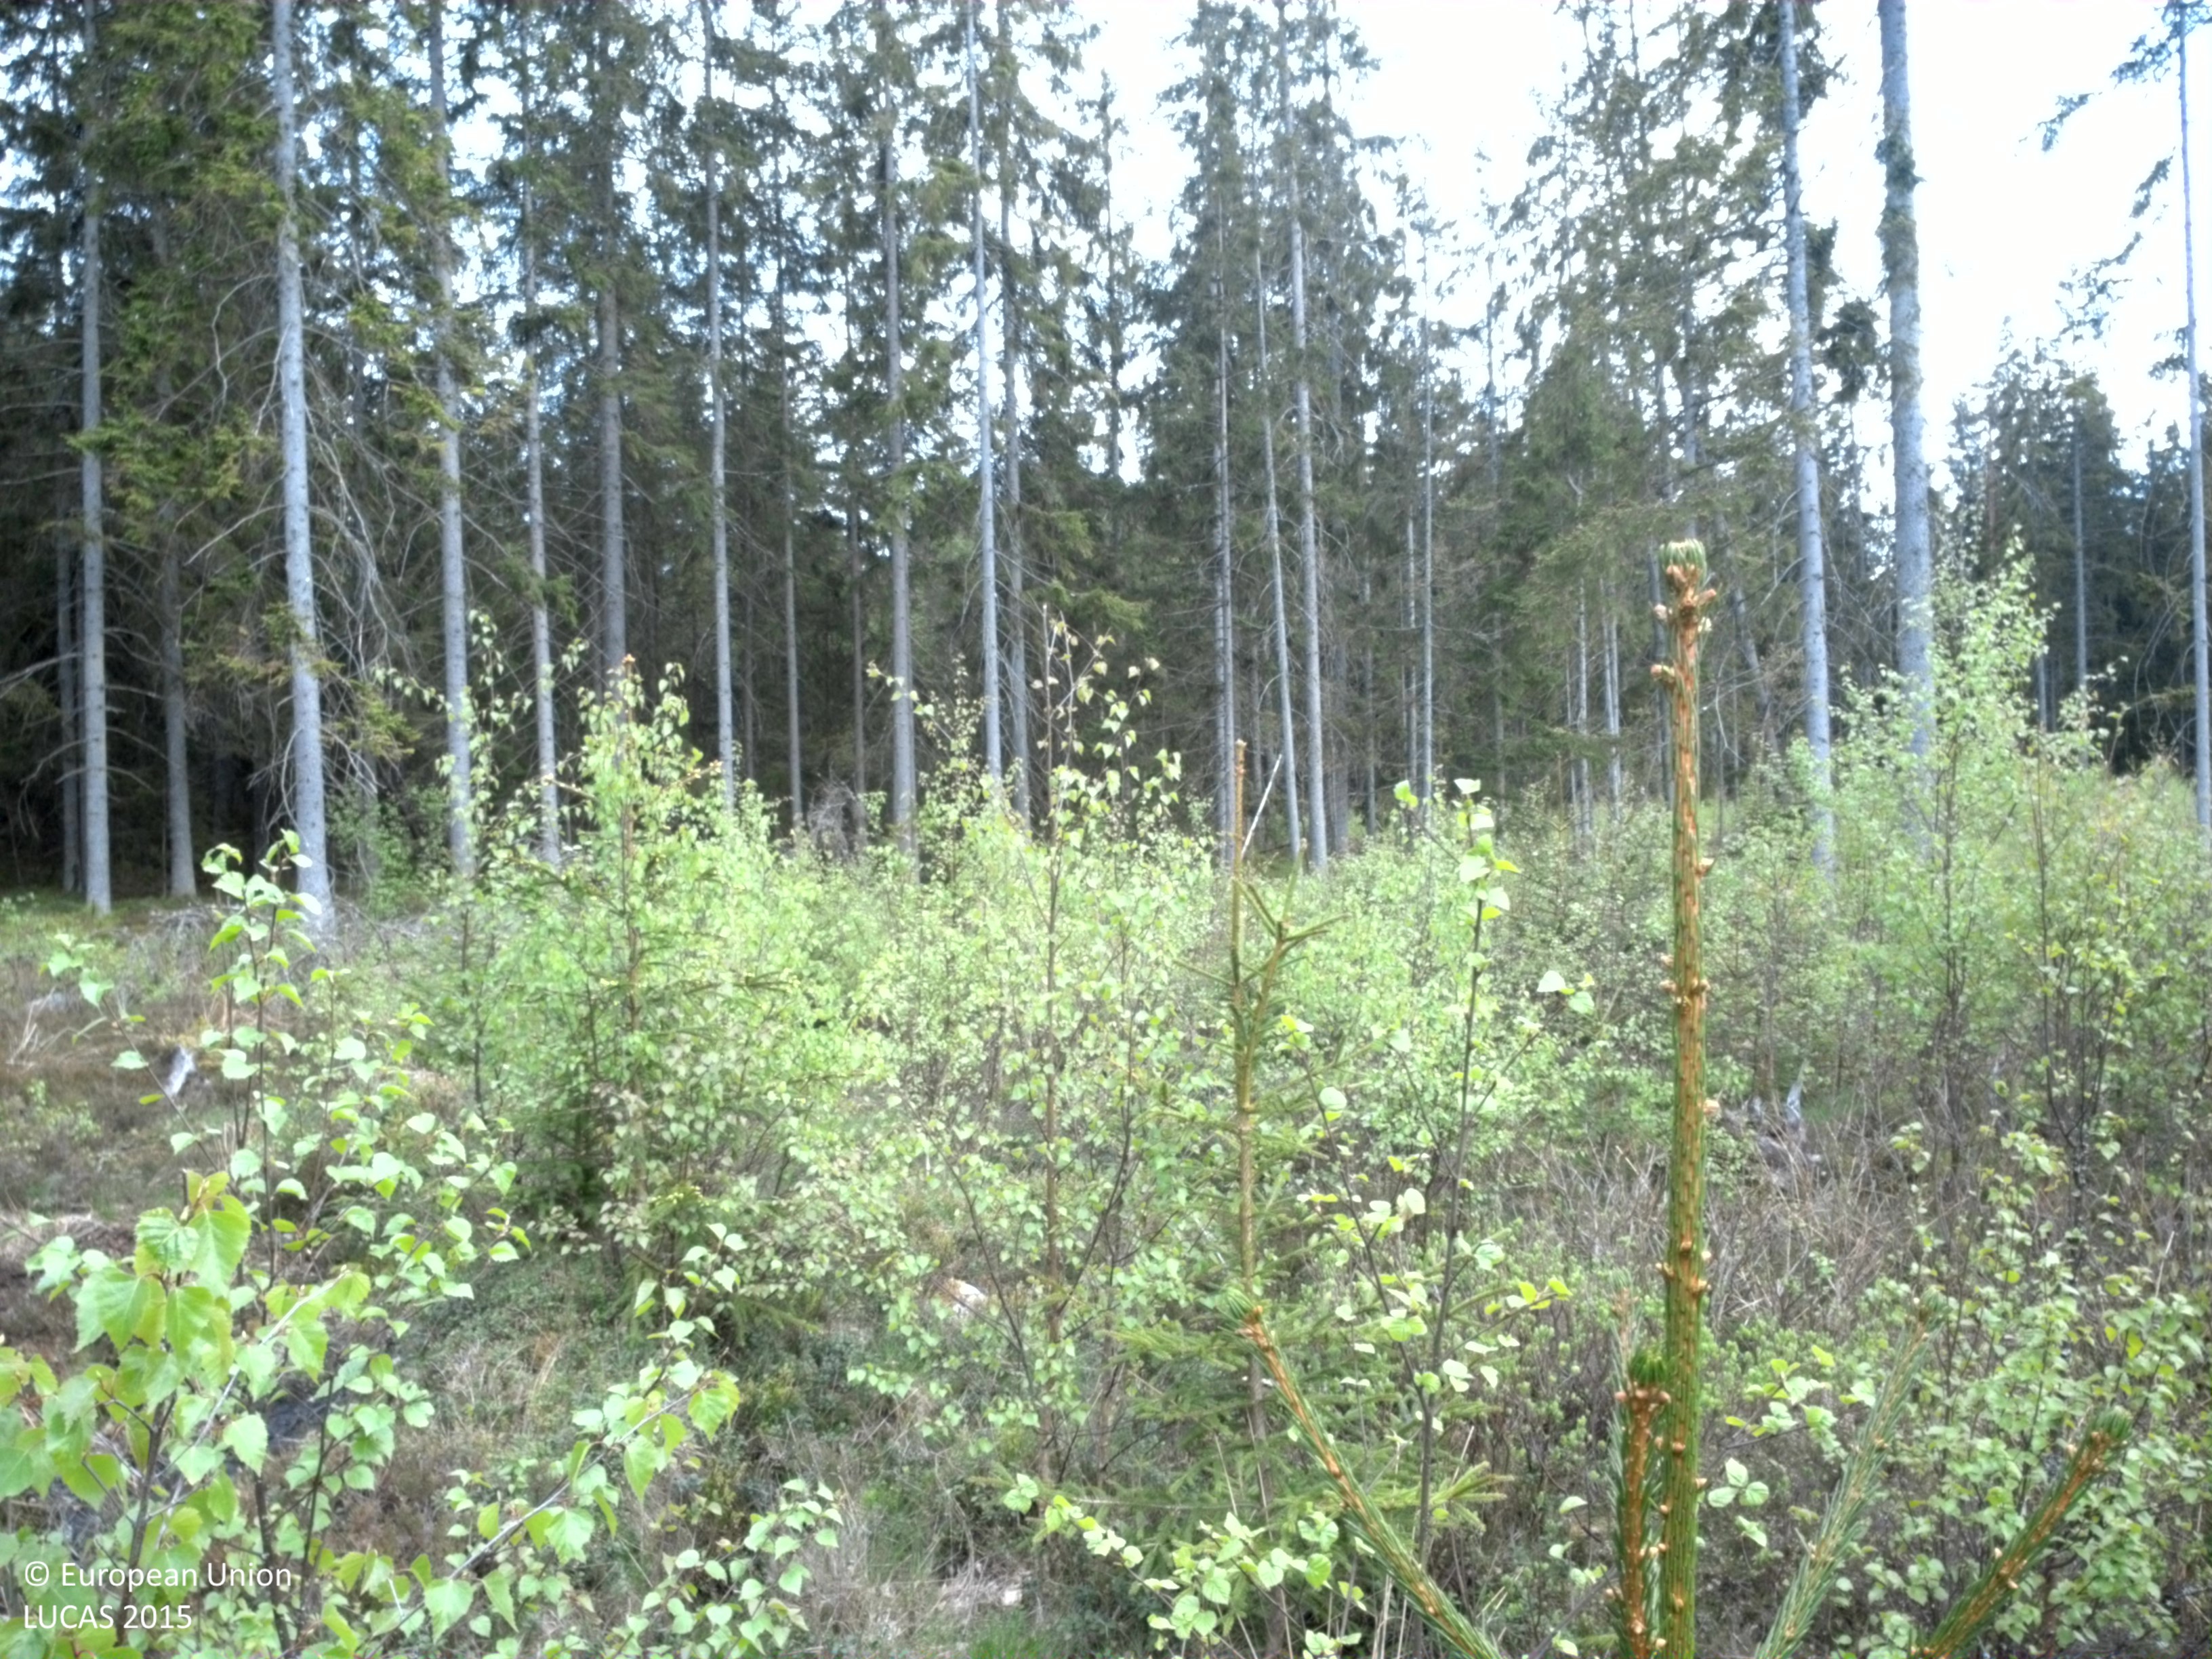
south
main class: Woodland
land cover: Spruce dominated mixed woodland
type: boreal forest
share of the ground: > 75 %
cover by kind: coniferous forest trees 40 %, broadleaved forest trees 40 %, shrubs 10 %, herbaceous plants 10 %
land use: Forestry
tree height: < 5 m
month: May
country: SE
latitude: 56.8010
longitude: 15.2544
